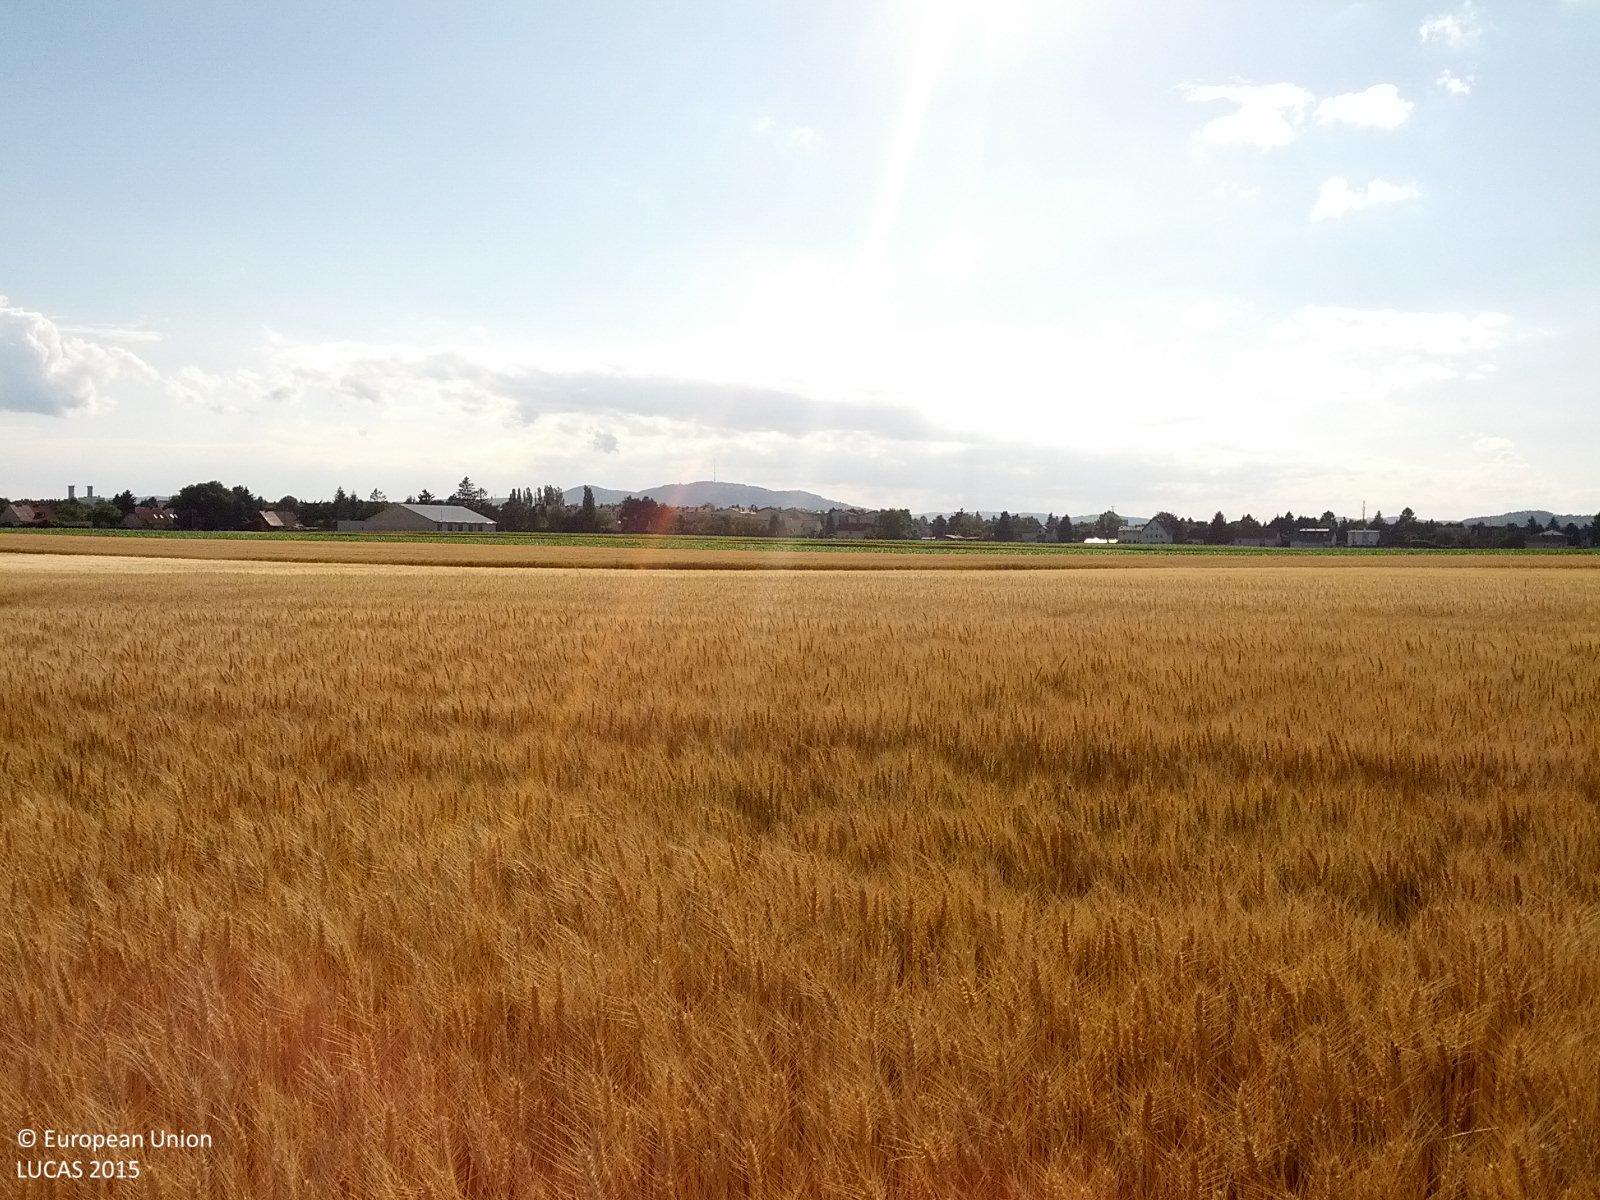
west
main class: Cropland
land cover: Common wheat
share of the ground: > 75 %
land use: Agriculture (excluding fallow land and kitchen gardens)
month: June
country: AT
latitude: 48.2867
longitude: 16.4611
